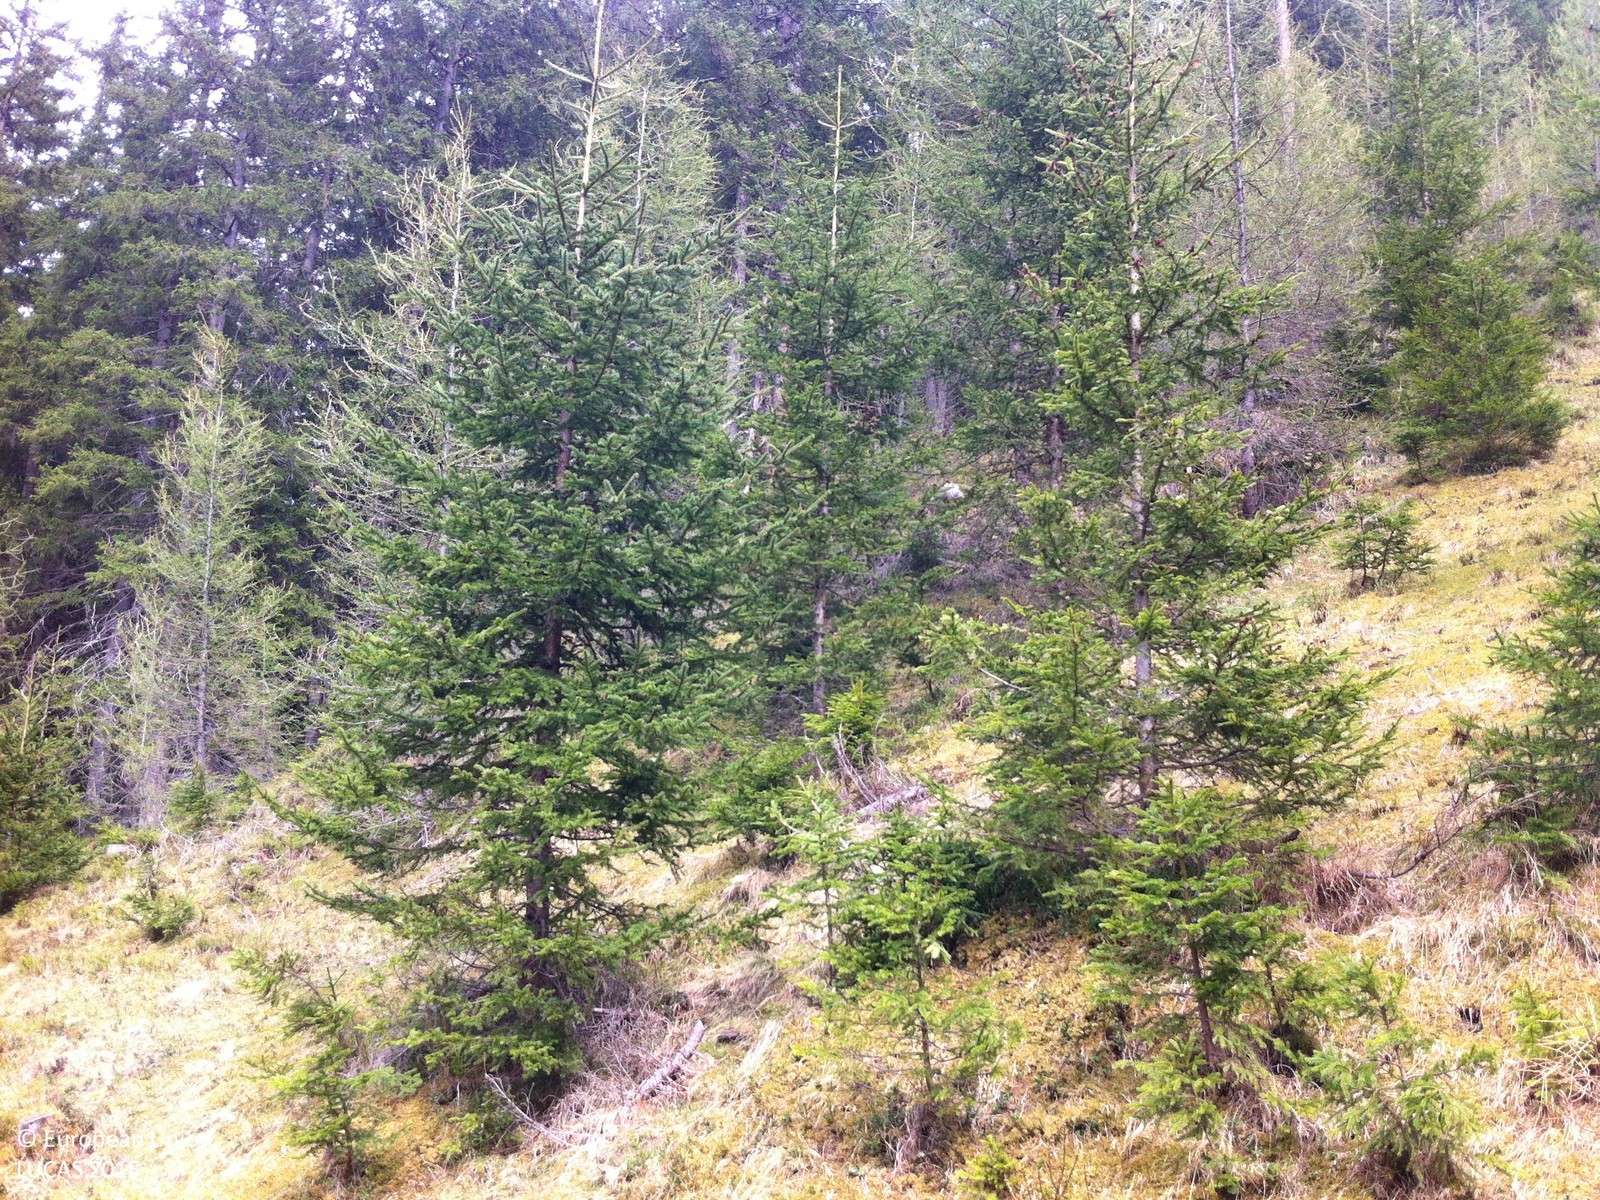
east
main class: Woodland
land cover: Spruce dominated coniferous woodland
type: alpine coniferous forest
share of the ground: 50 - 75 %
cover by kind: coniferous forest trees 55 %, herbaceous plants 25 %, lichens and mosses 20 %
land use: Forestry
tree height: < 5 m
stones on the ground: < 10 %
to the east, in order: Spruce dominated coniferous woodland; Tracks; Spruce dominated coniferous woodland; Other coniferous woodland
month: May
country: AT
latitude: 47.0782
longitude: 11.5658
